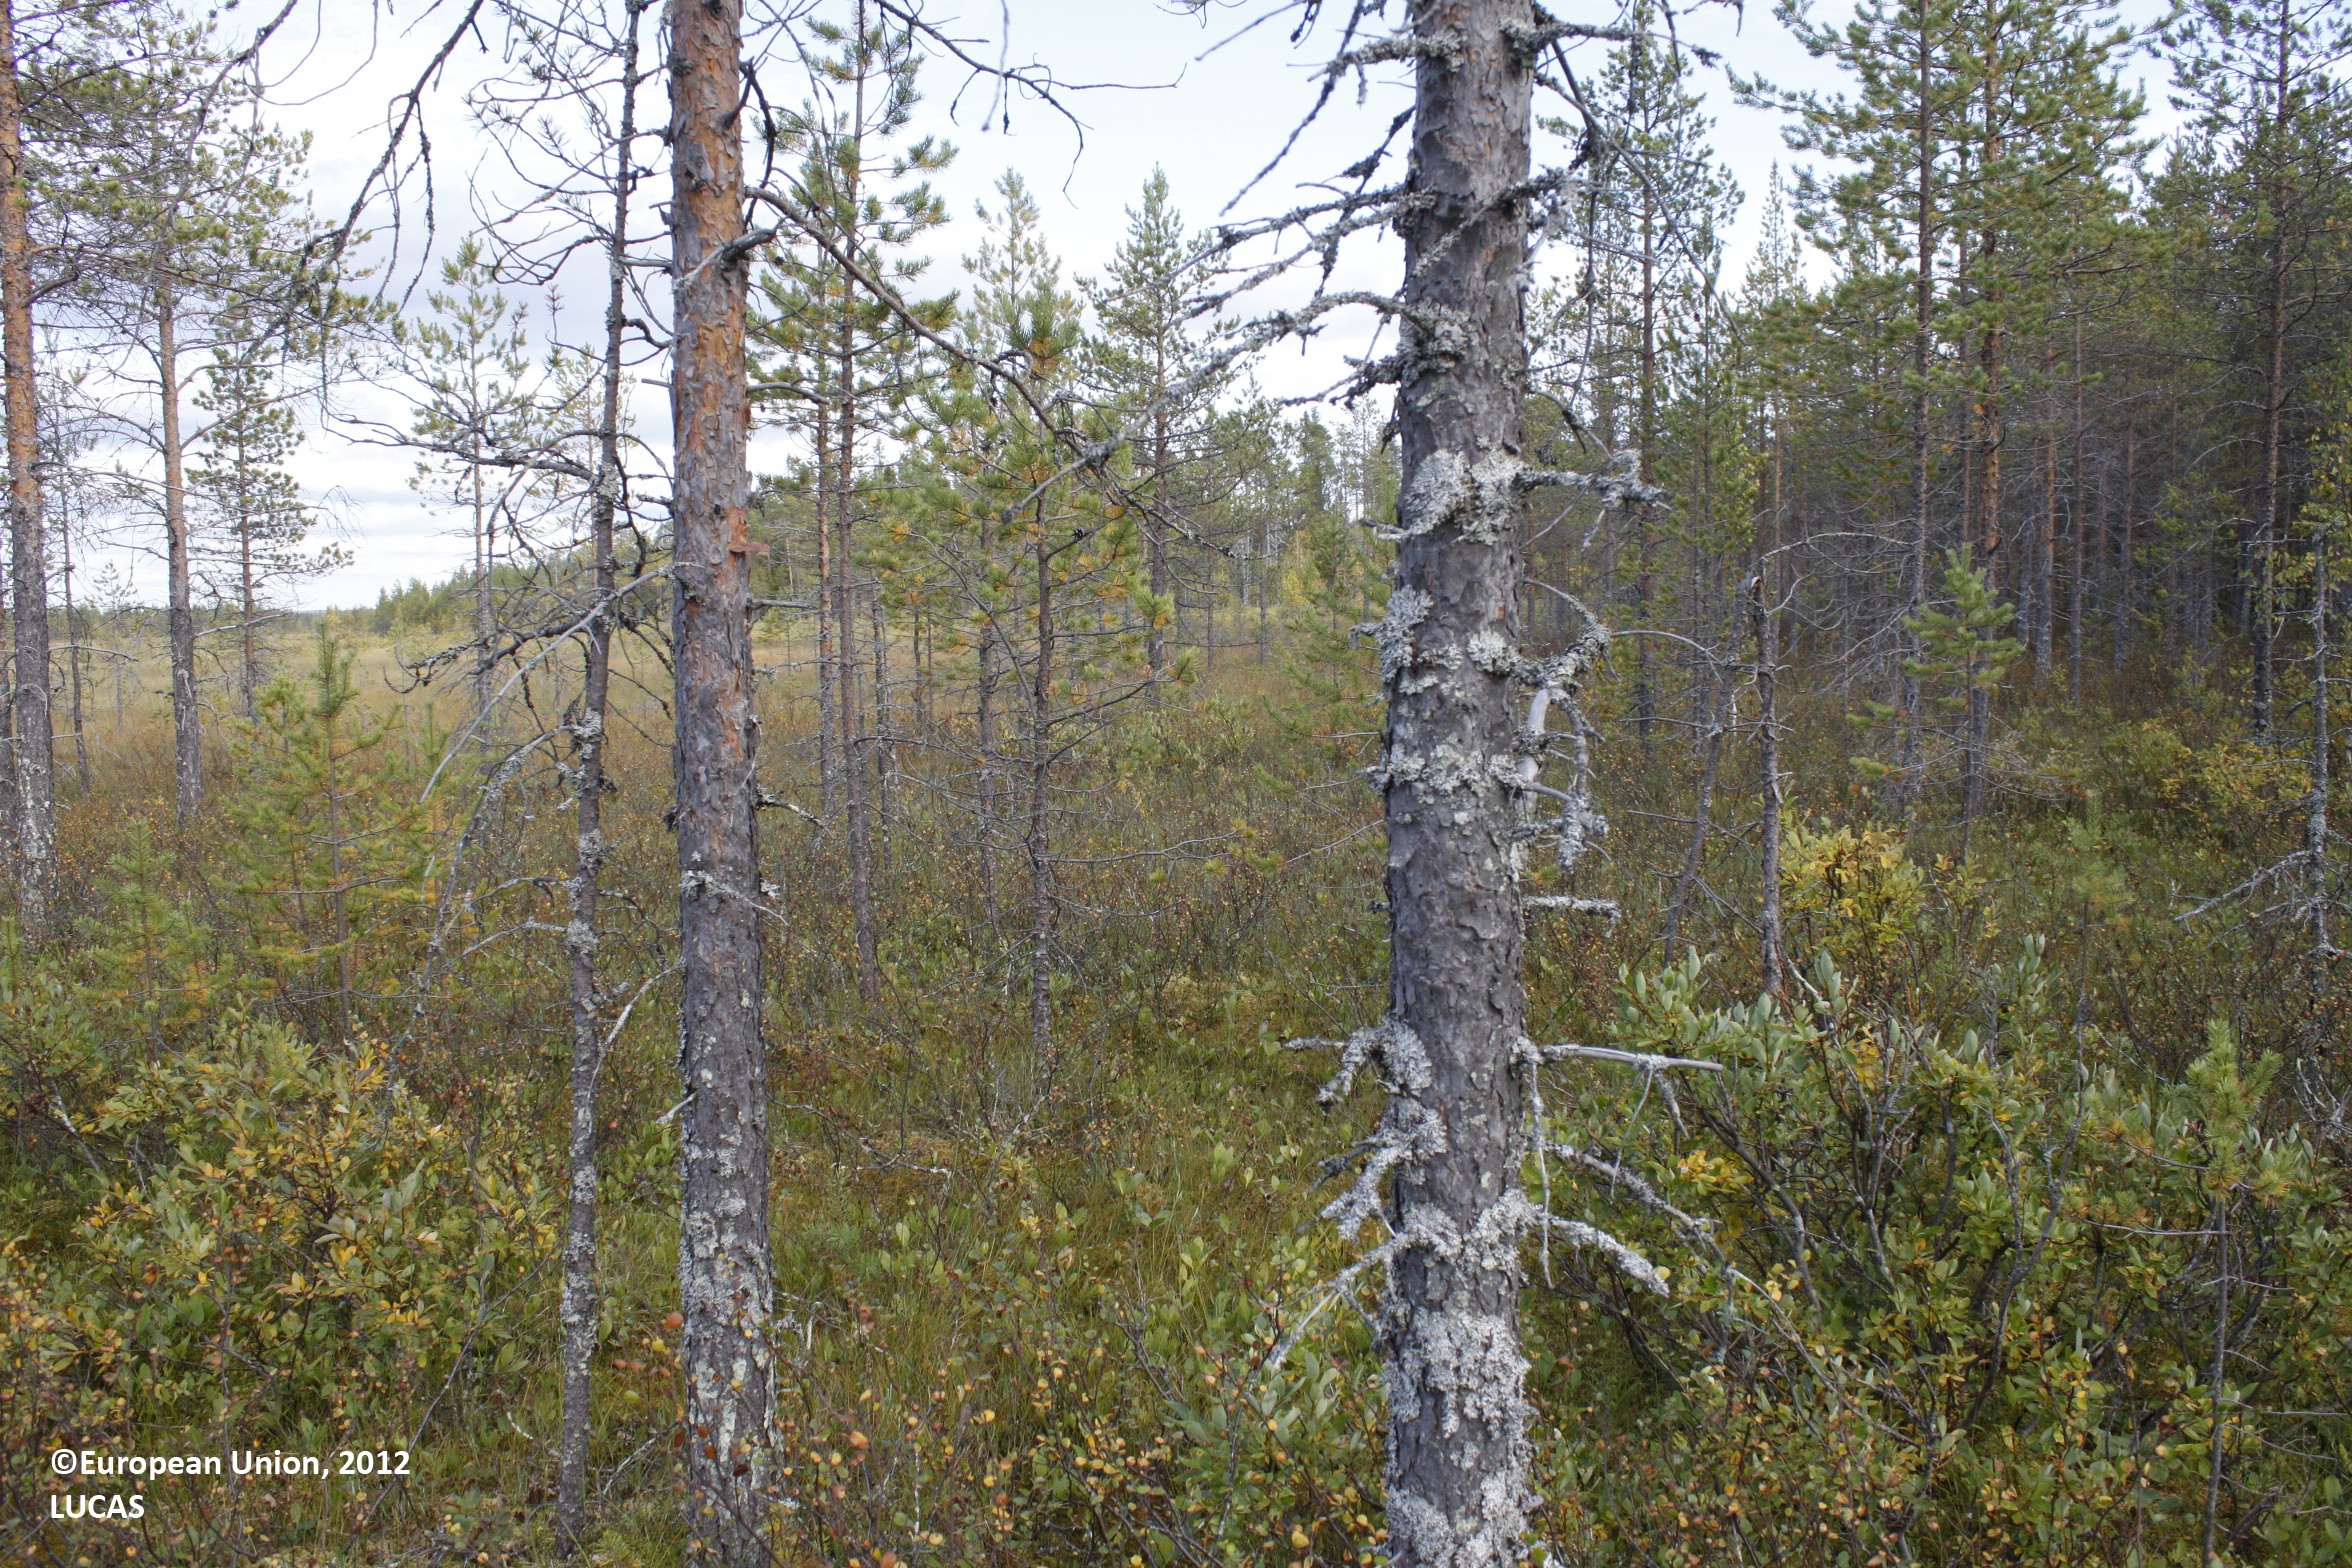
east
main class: Woodland
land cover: Pine dominated coniferous woodland
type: mire and swamp forests
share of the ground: 25 - 50 %
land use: Semi-natural and natural areas not in use
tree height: > 5 m
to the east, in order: Pine dominated coniferous woodland; Peatbogs
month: September
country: FI
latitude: 65.4144
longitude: 27.2479
